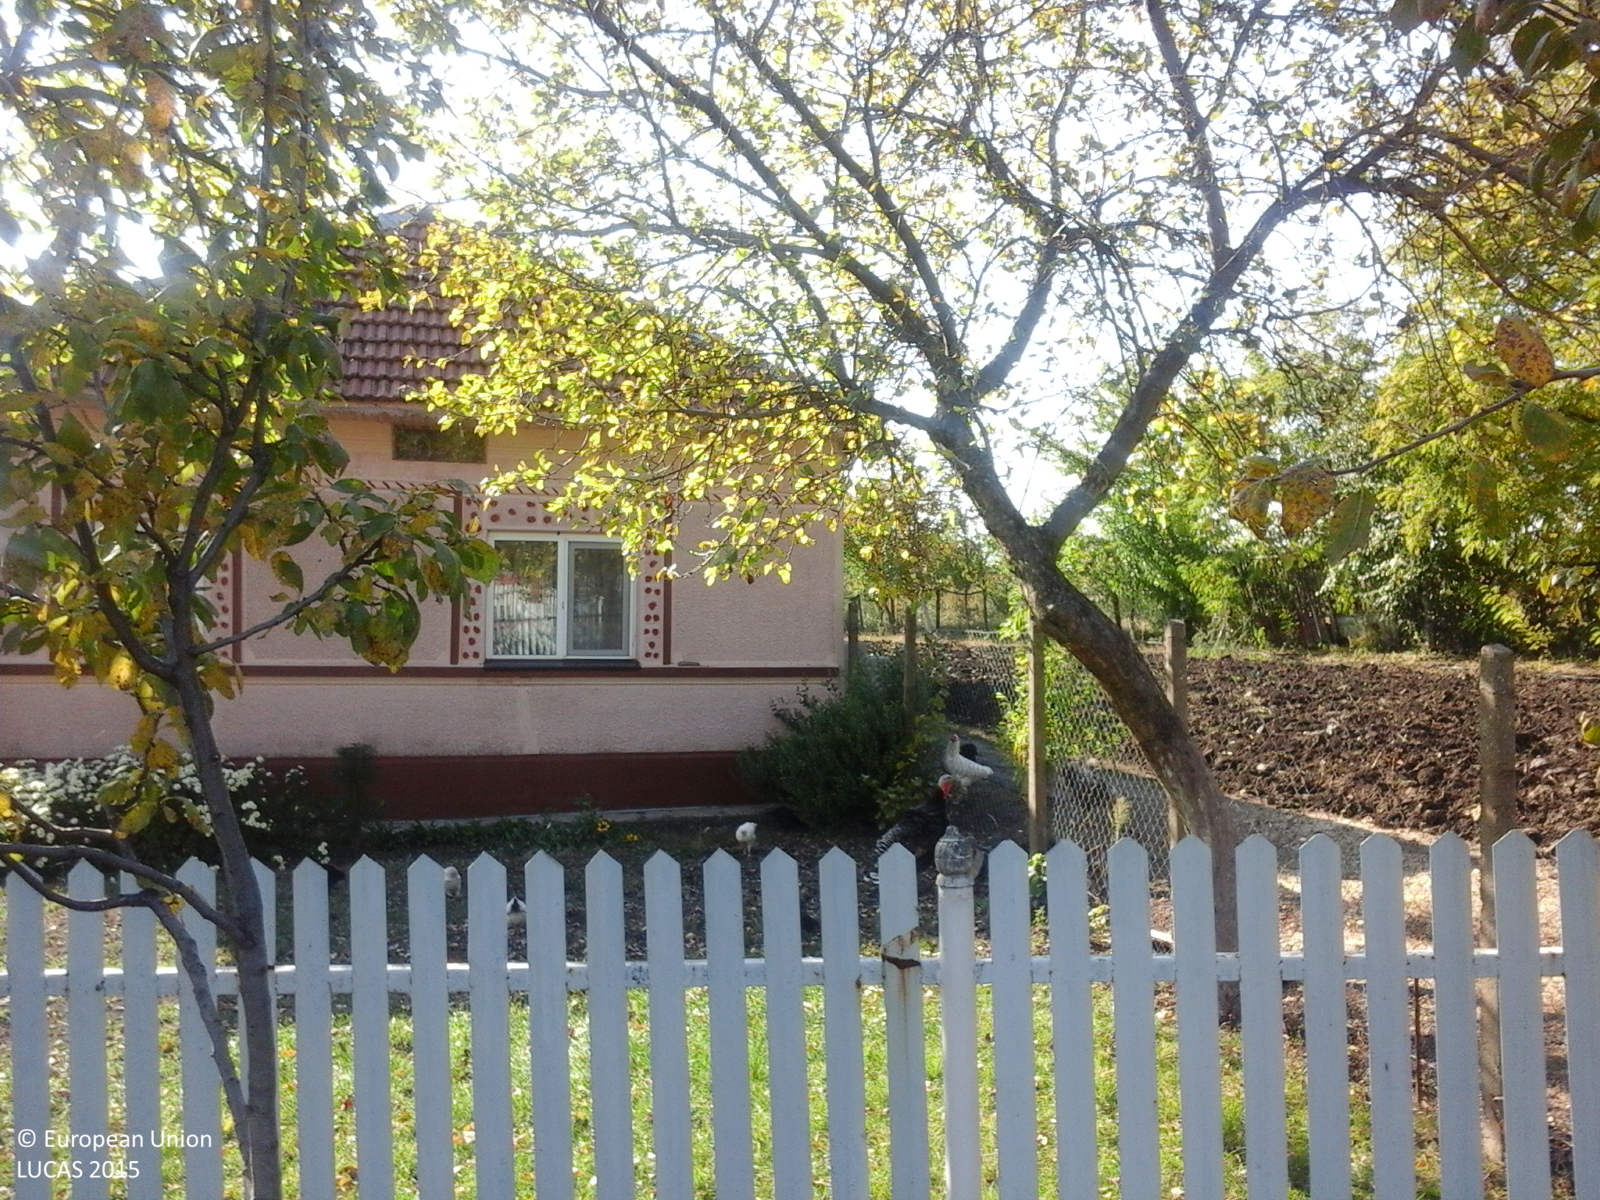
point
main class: Grassland
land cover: Grassland without tree/shrub cover
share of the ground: > 75 %
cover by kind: herbaceous plants 100 %
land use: Agriculture (excluding fallow land and kitchen gardens)
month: October
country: RO
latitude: 45.2827
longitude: 26.8201
